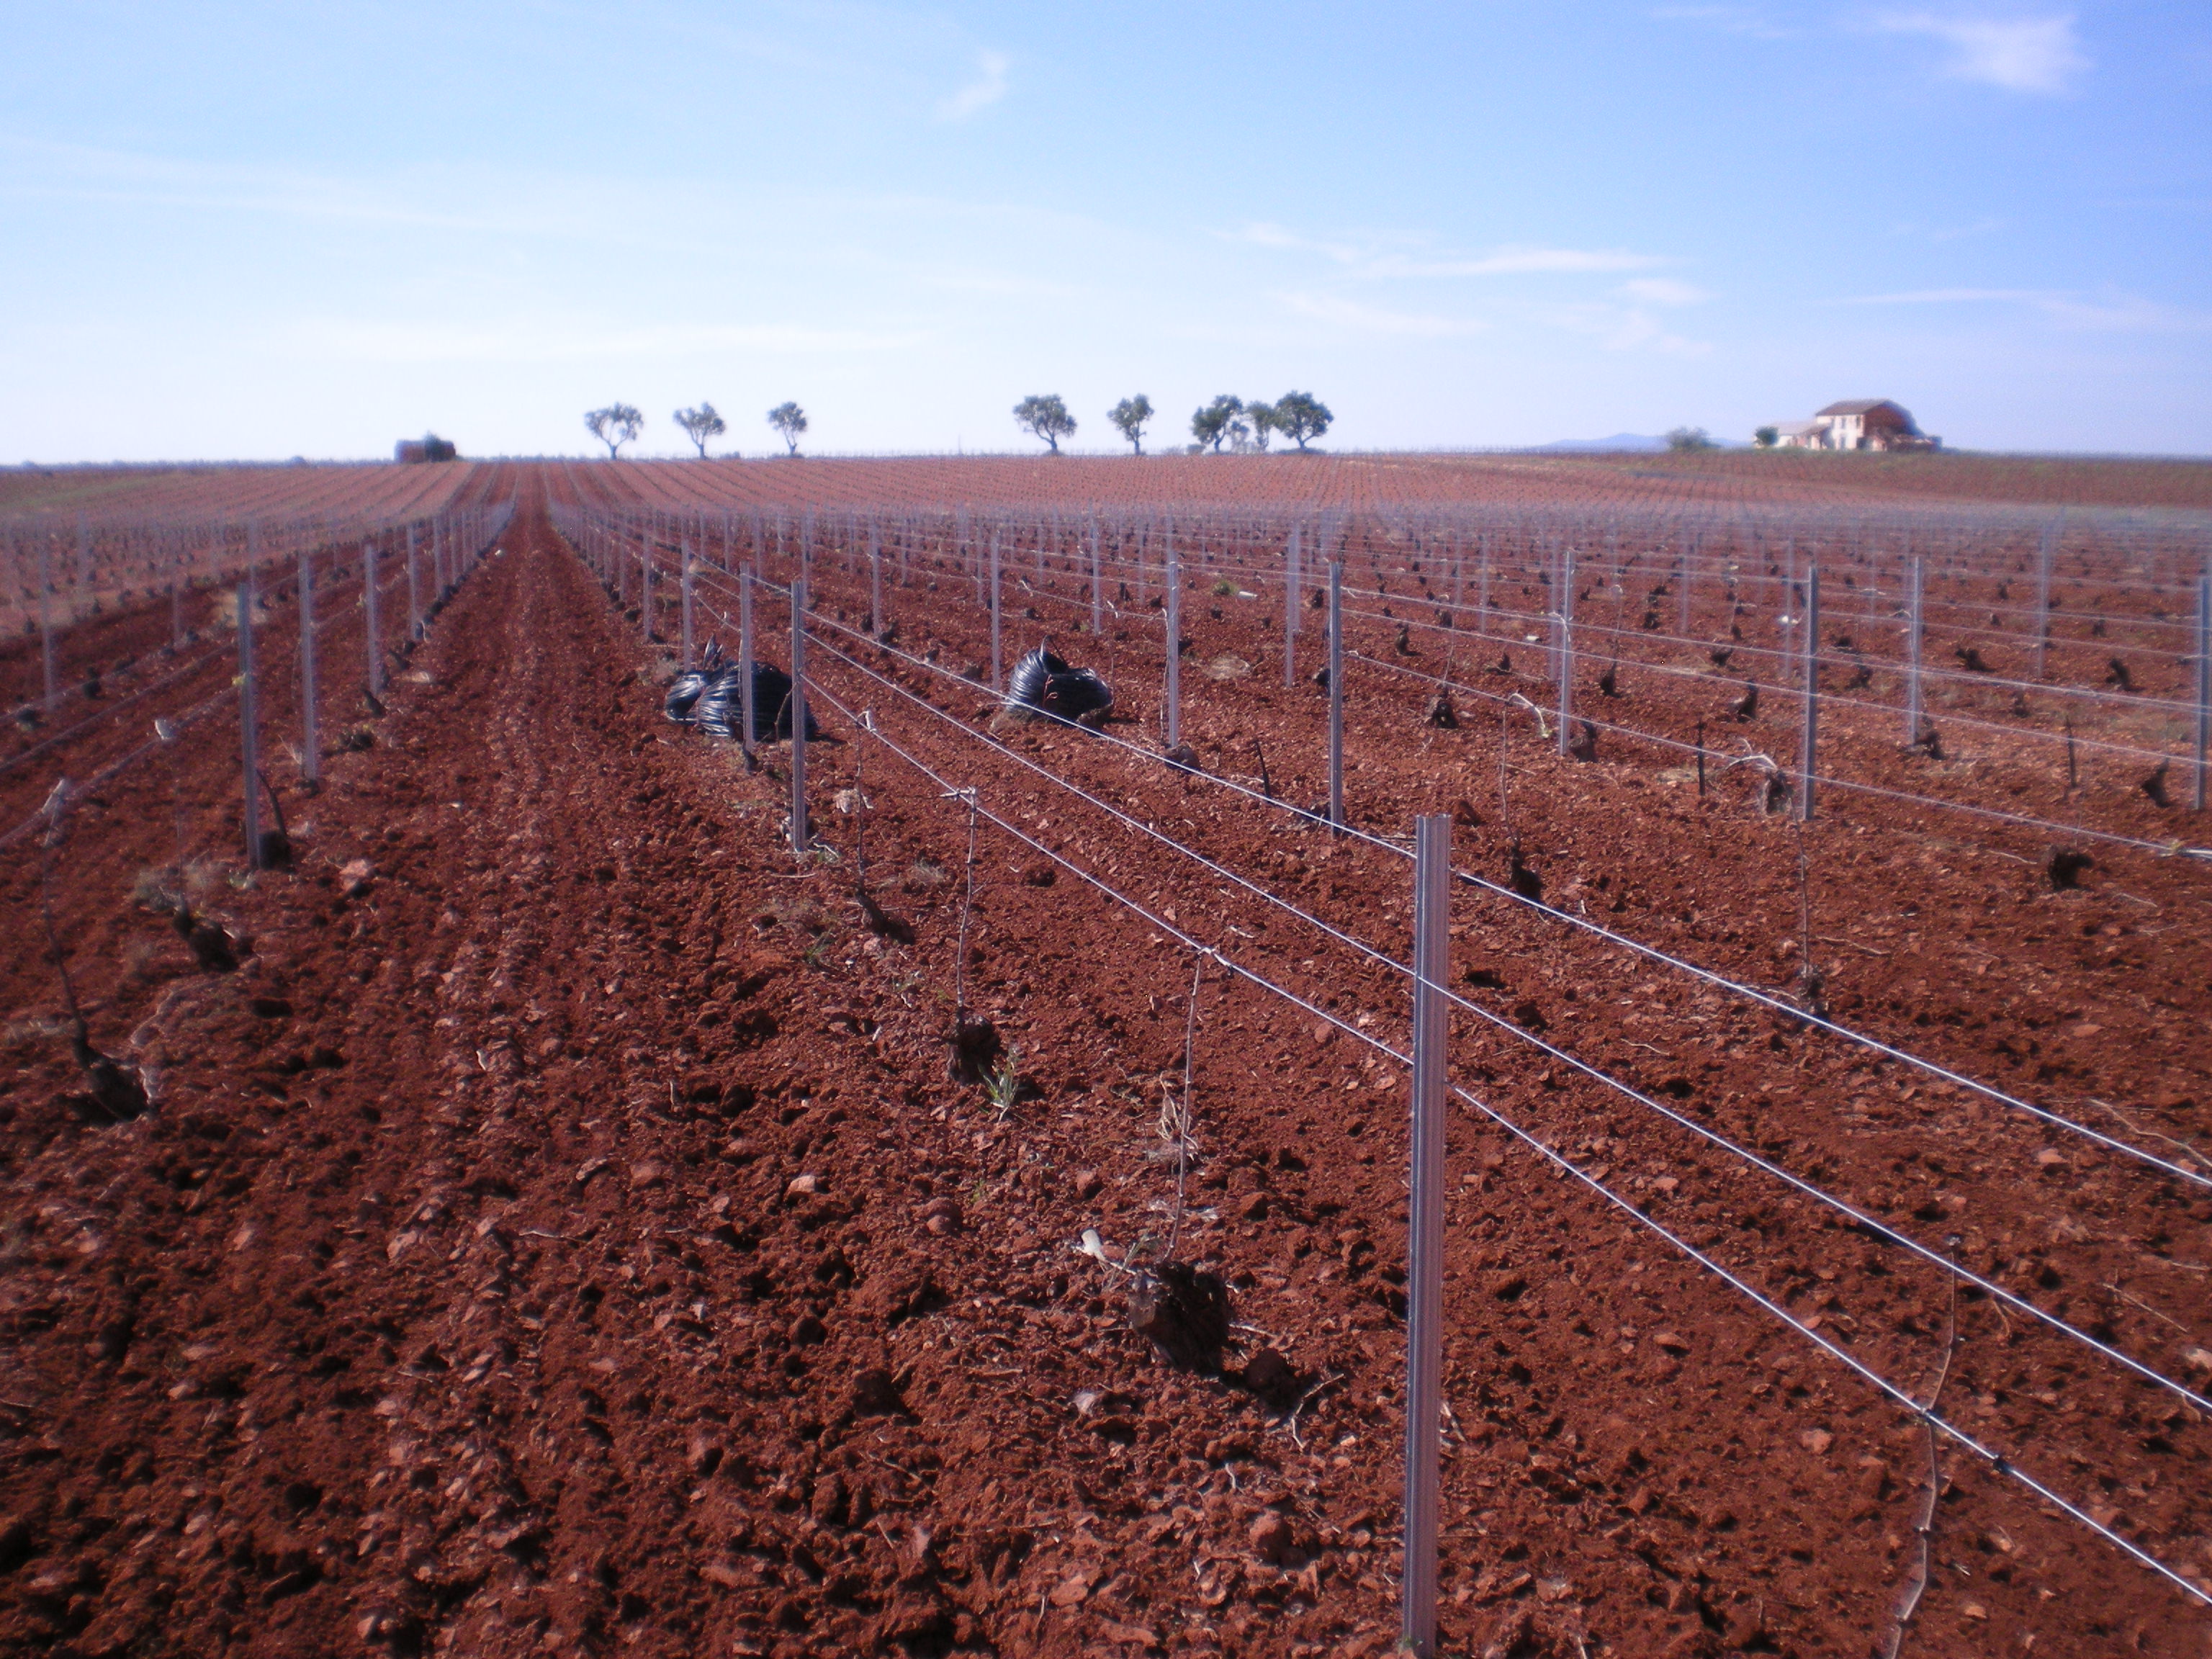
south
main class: Cropland
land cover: Vineyards
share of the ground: < 10 %
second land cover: Other bare soil
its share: > 75 %
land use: Agriculture (excluding fallow land and kitchen gardens)
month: April
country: ES
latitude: 38.8220
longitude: -3.1979
